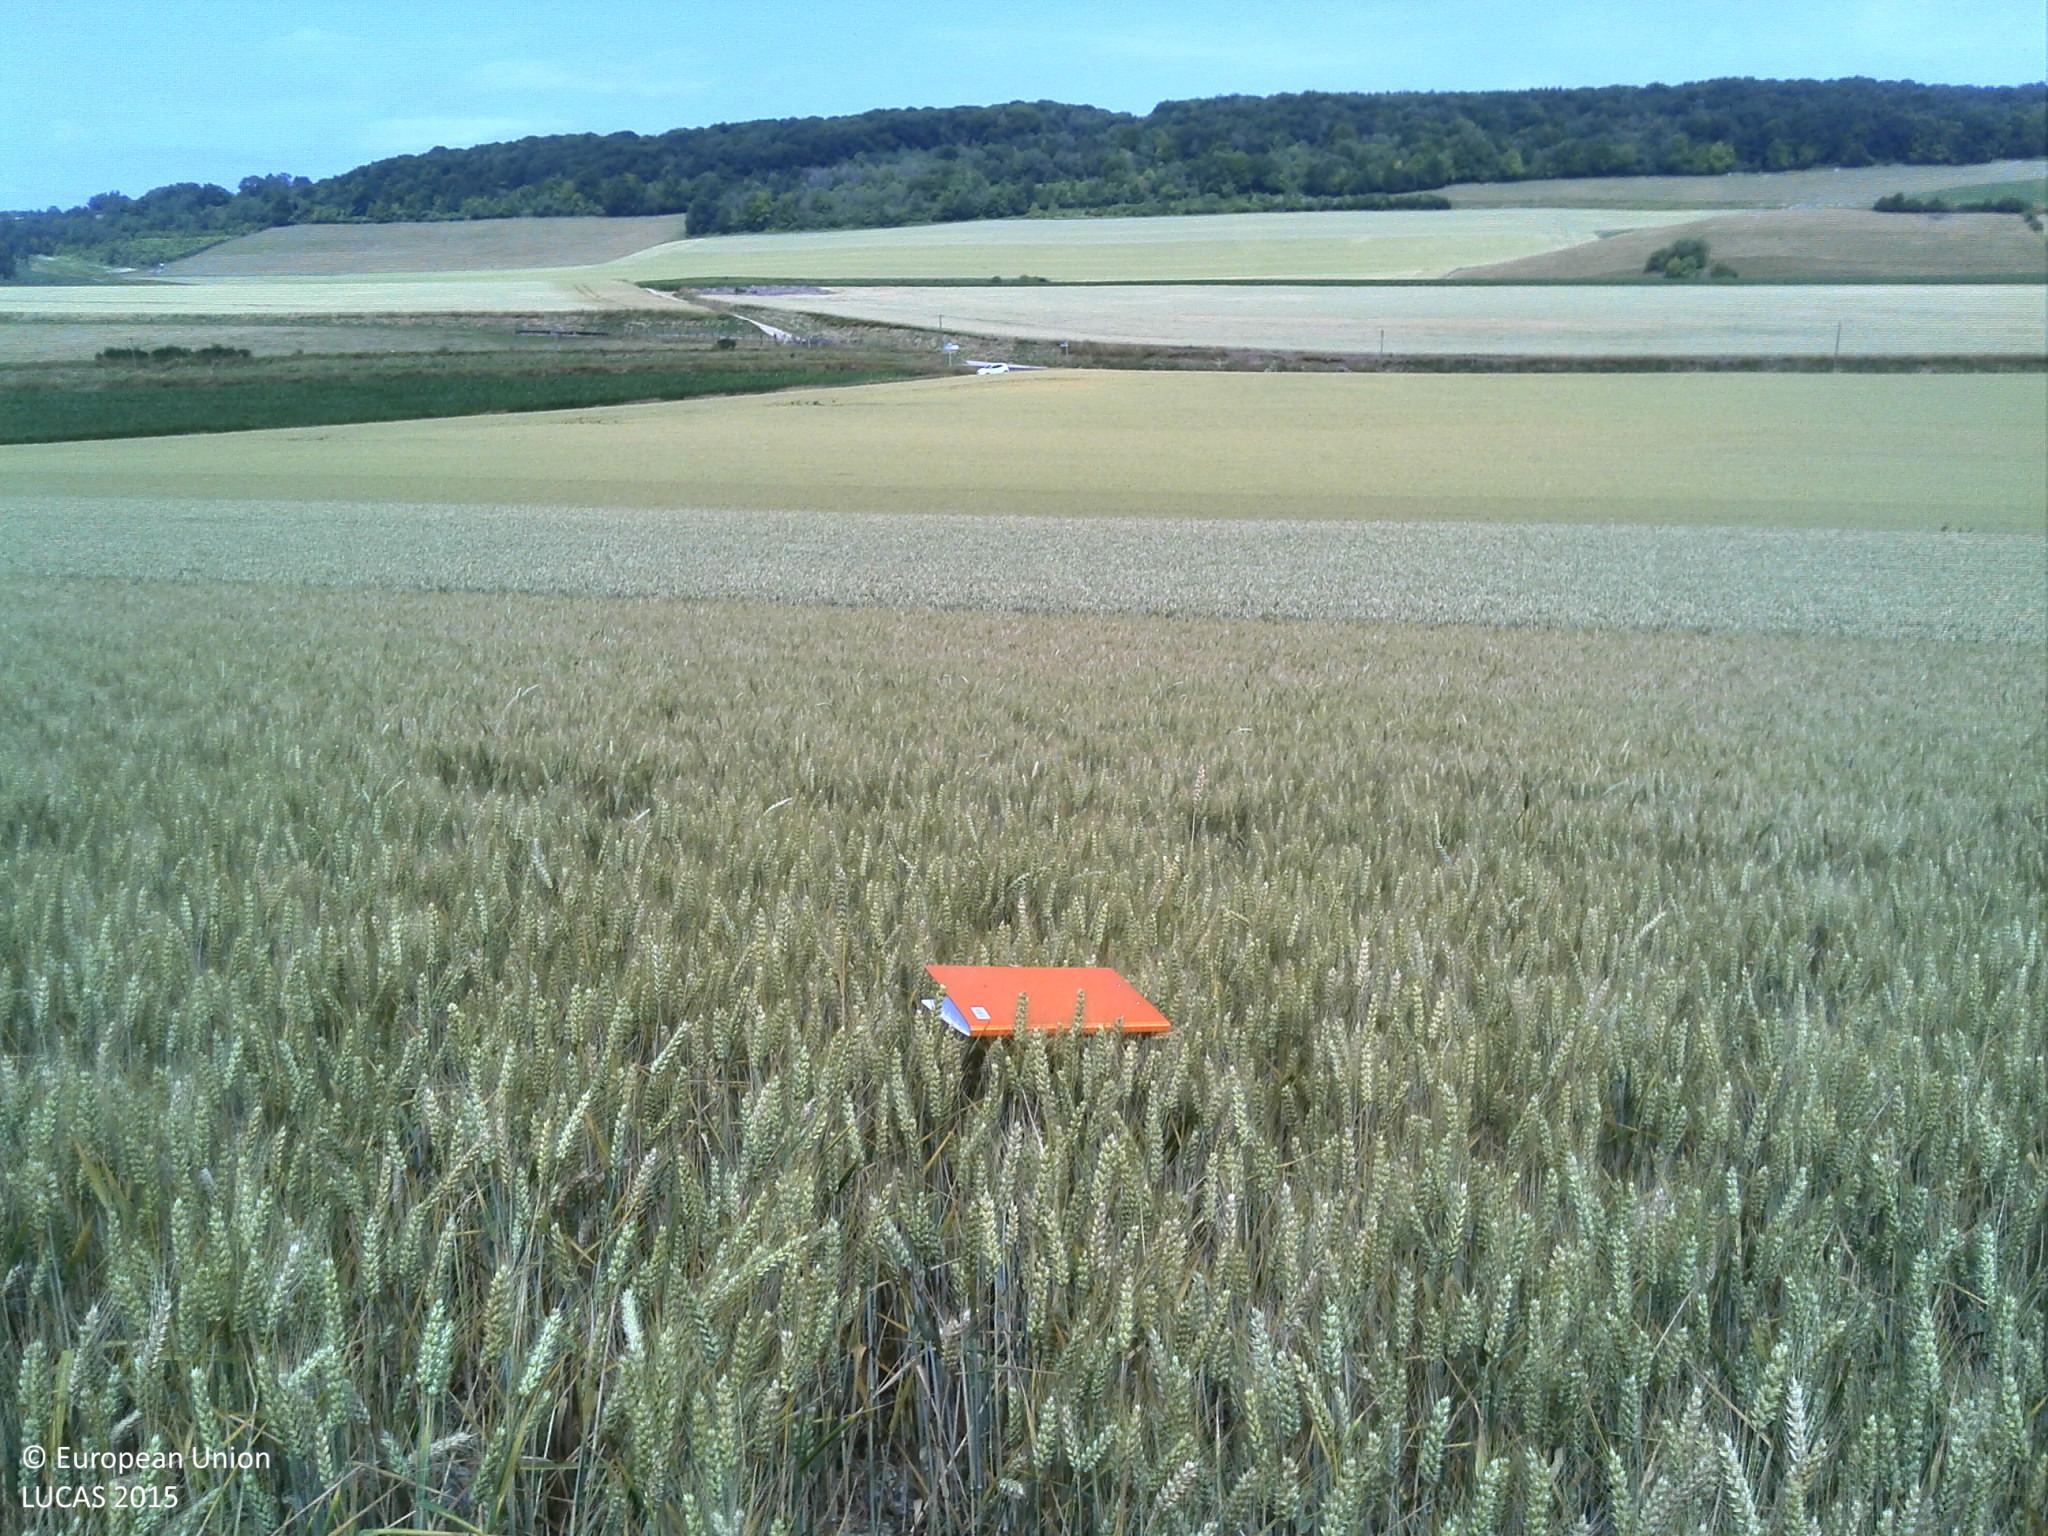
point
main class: Cropland
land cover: Durum wheat
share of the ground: > 75 %
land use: Agriculture (excluding fallow land and kitchen gardens)
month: July
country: FR
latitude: 49.8279
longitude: 1.7114
